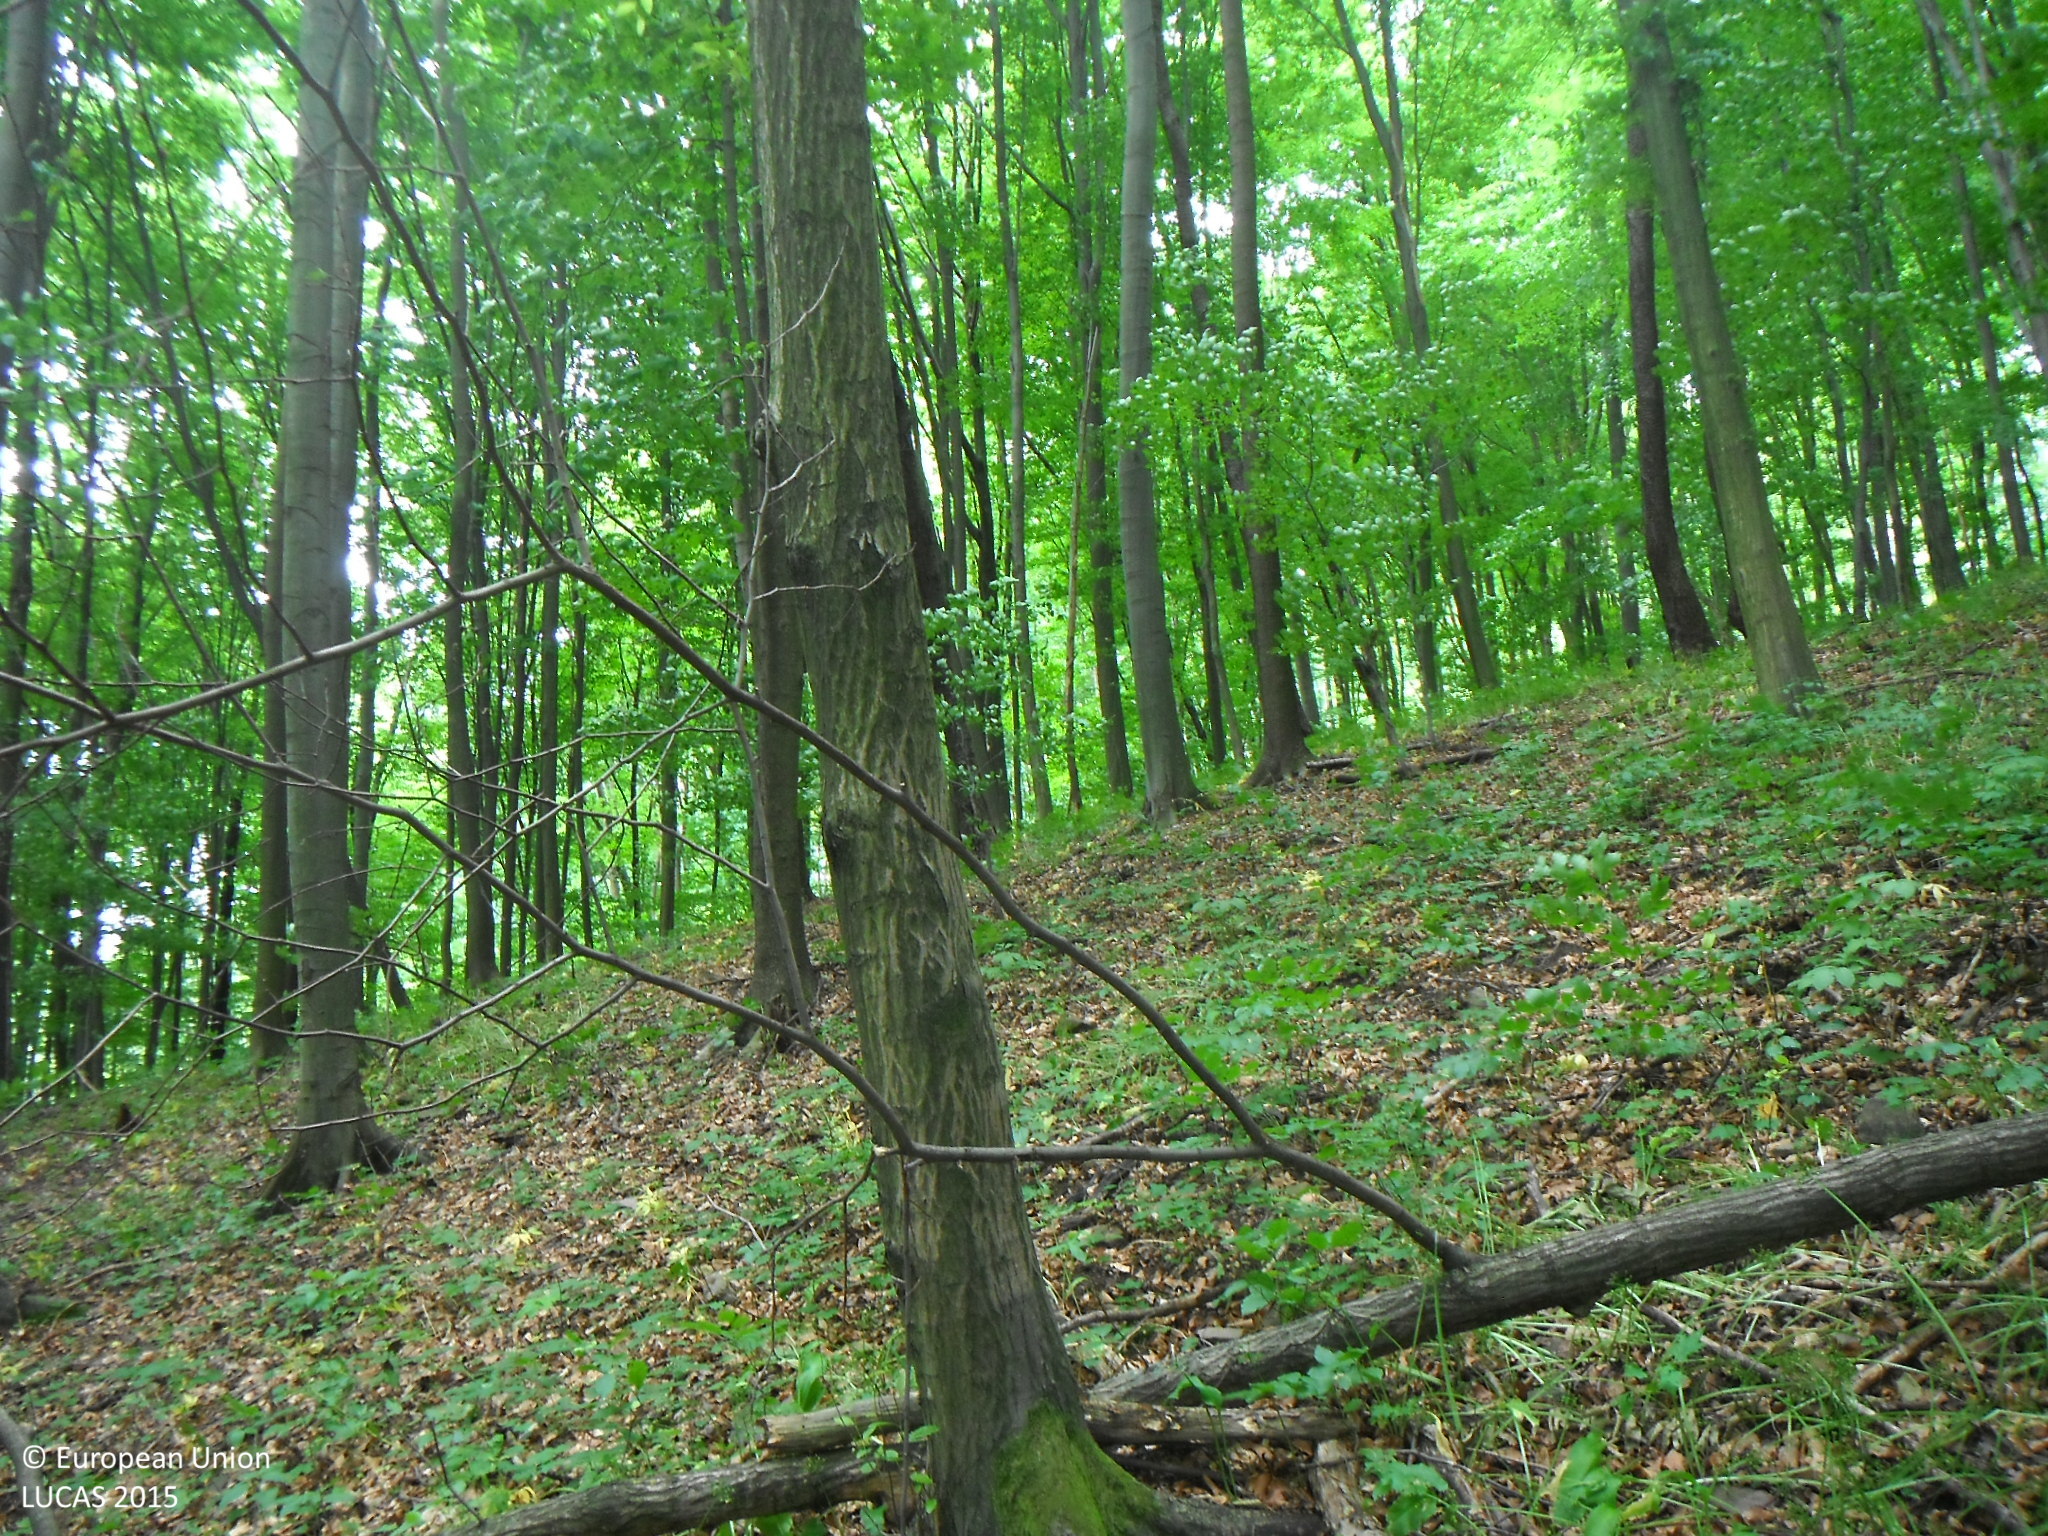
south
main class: Woodland
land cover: Broadleaved woodland
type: beech forest
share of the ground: > 75 %
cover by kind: broadleaved forest trees 100 %
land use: Forestry
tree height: > 5 m
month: June
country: SK
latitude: 49.1677
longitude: 21.6400
